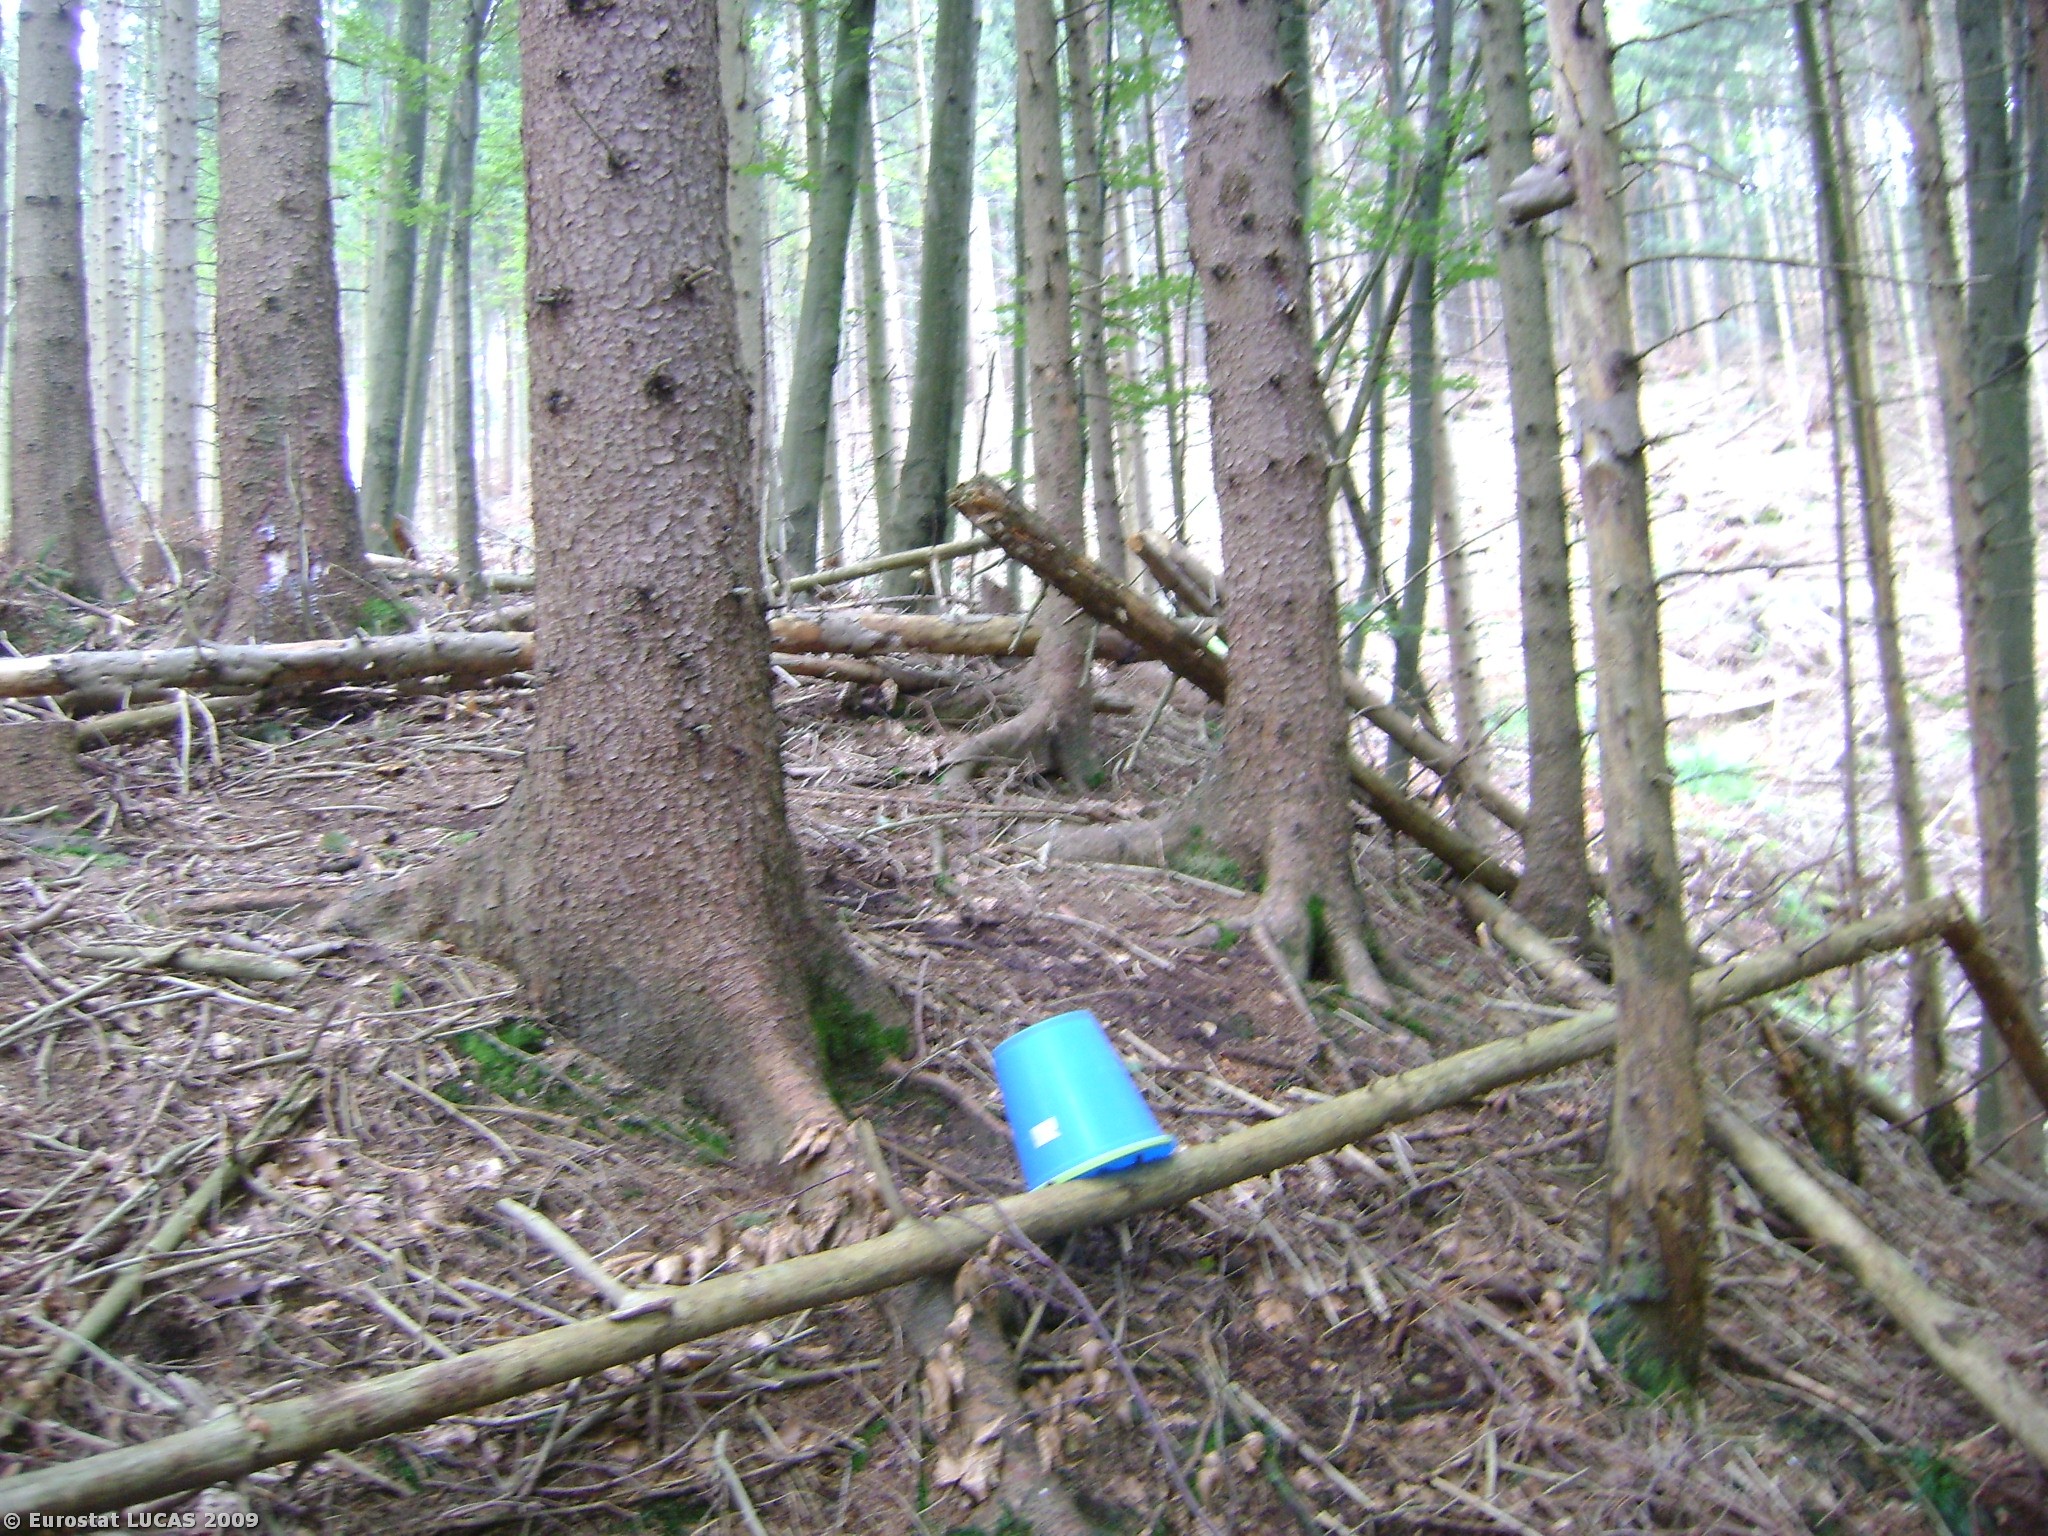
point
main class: Woodland
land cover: Mixed woodland
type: hemiboreal forest and nemoral coniferous forest and mixed broadleaved-coniferous forest
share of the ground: > 75 %
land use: Forestry
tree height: > 5 m
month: August
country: AT
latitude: 47.9055
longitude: 13.2497
